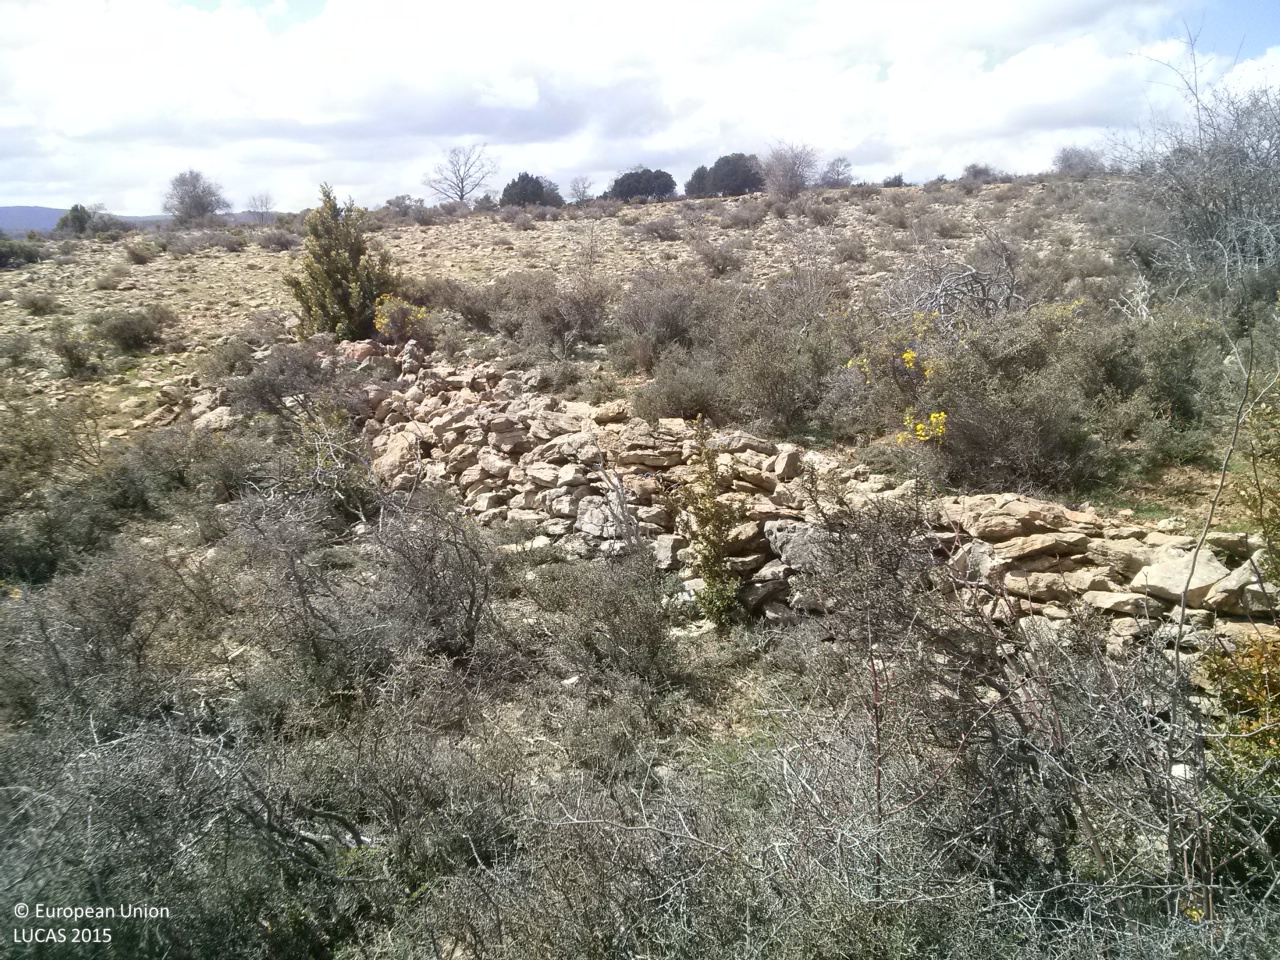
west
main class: Shrubland
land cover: Shrubland without tree cover
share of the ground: > 75 %
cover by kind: shrubs 80 %, herbaceous plants 20 %
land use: Agriculture (excluding fallow land and kitchen gardens)
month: April
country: ES
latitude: 40.1733
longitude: -1.6501
